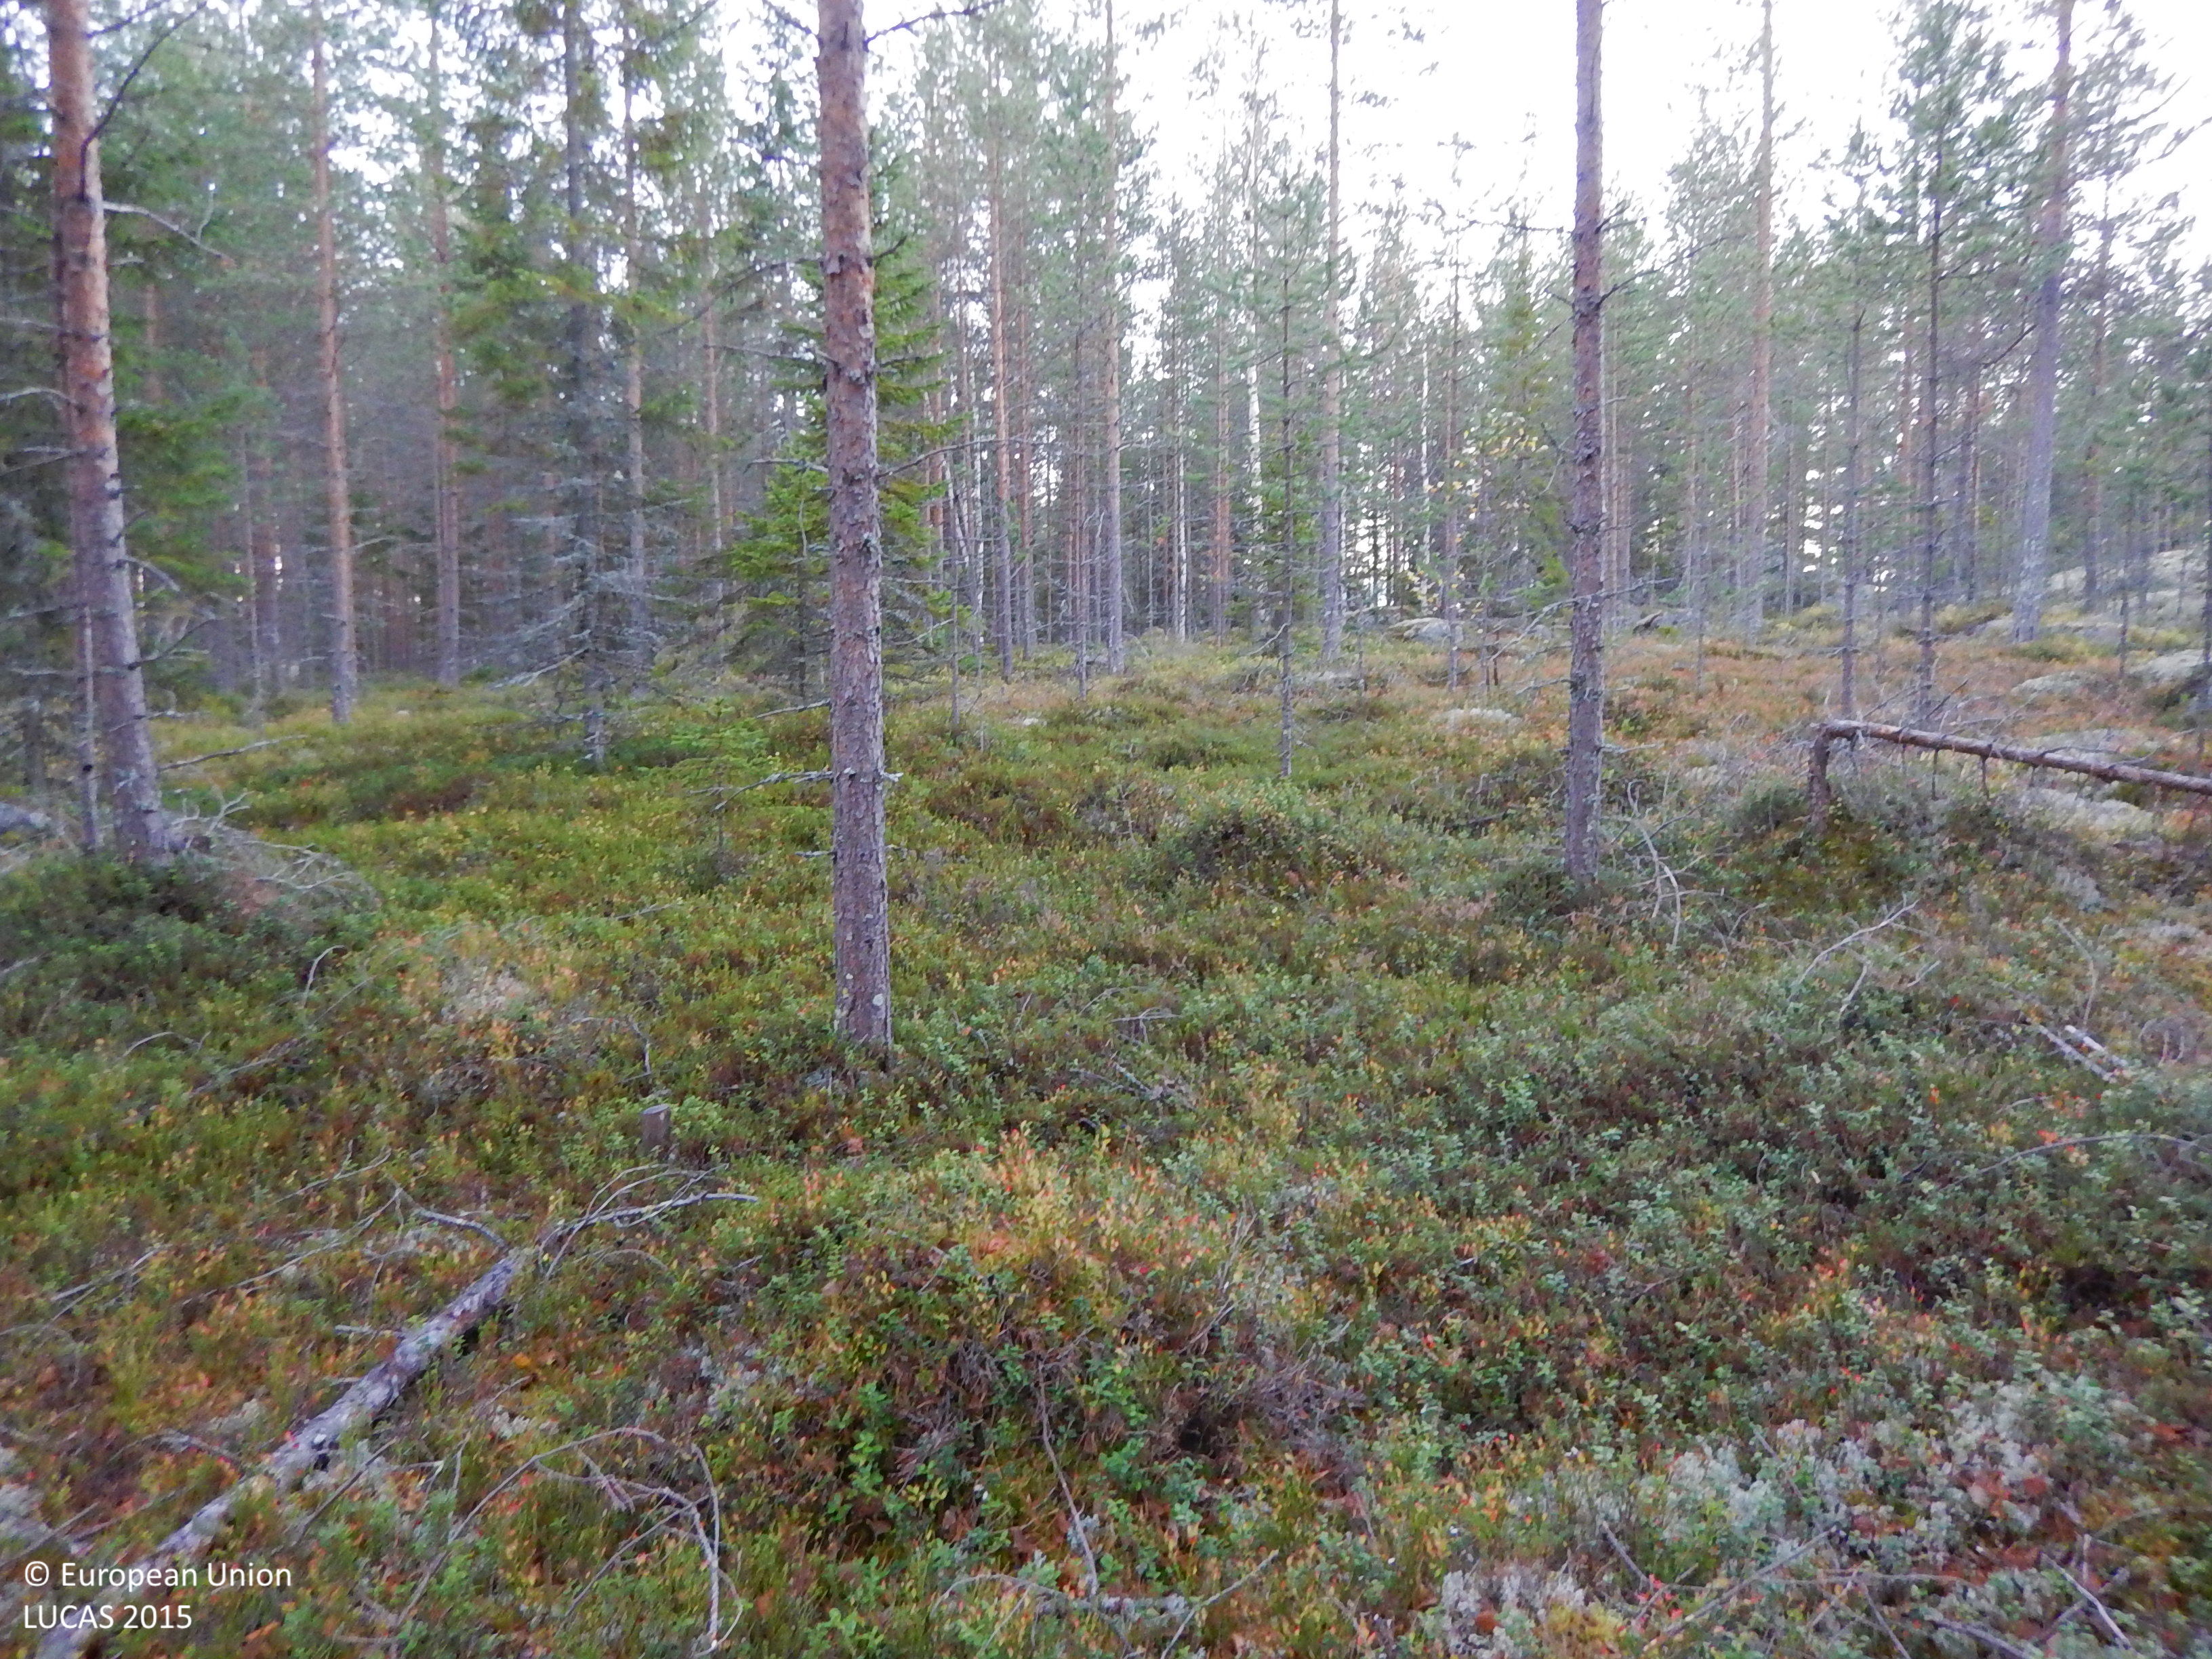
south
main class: Woodland
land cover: Pine dominated coniferous woodland
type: boreal forest
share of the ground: 50 - 75 %
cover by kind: coniferous forest trees 45 %, shrubs 20 %, lichens and mosses 20 %, broadleaved forest trees 5 %, herbaceous plants 5 %, consolidated bare surface 5 %
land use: Forestry
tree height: > 5 m
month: October
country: SE
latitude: 64.9317
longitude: 20.9543
